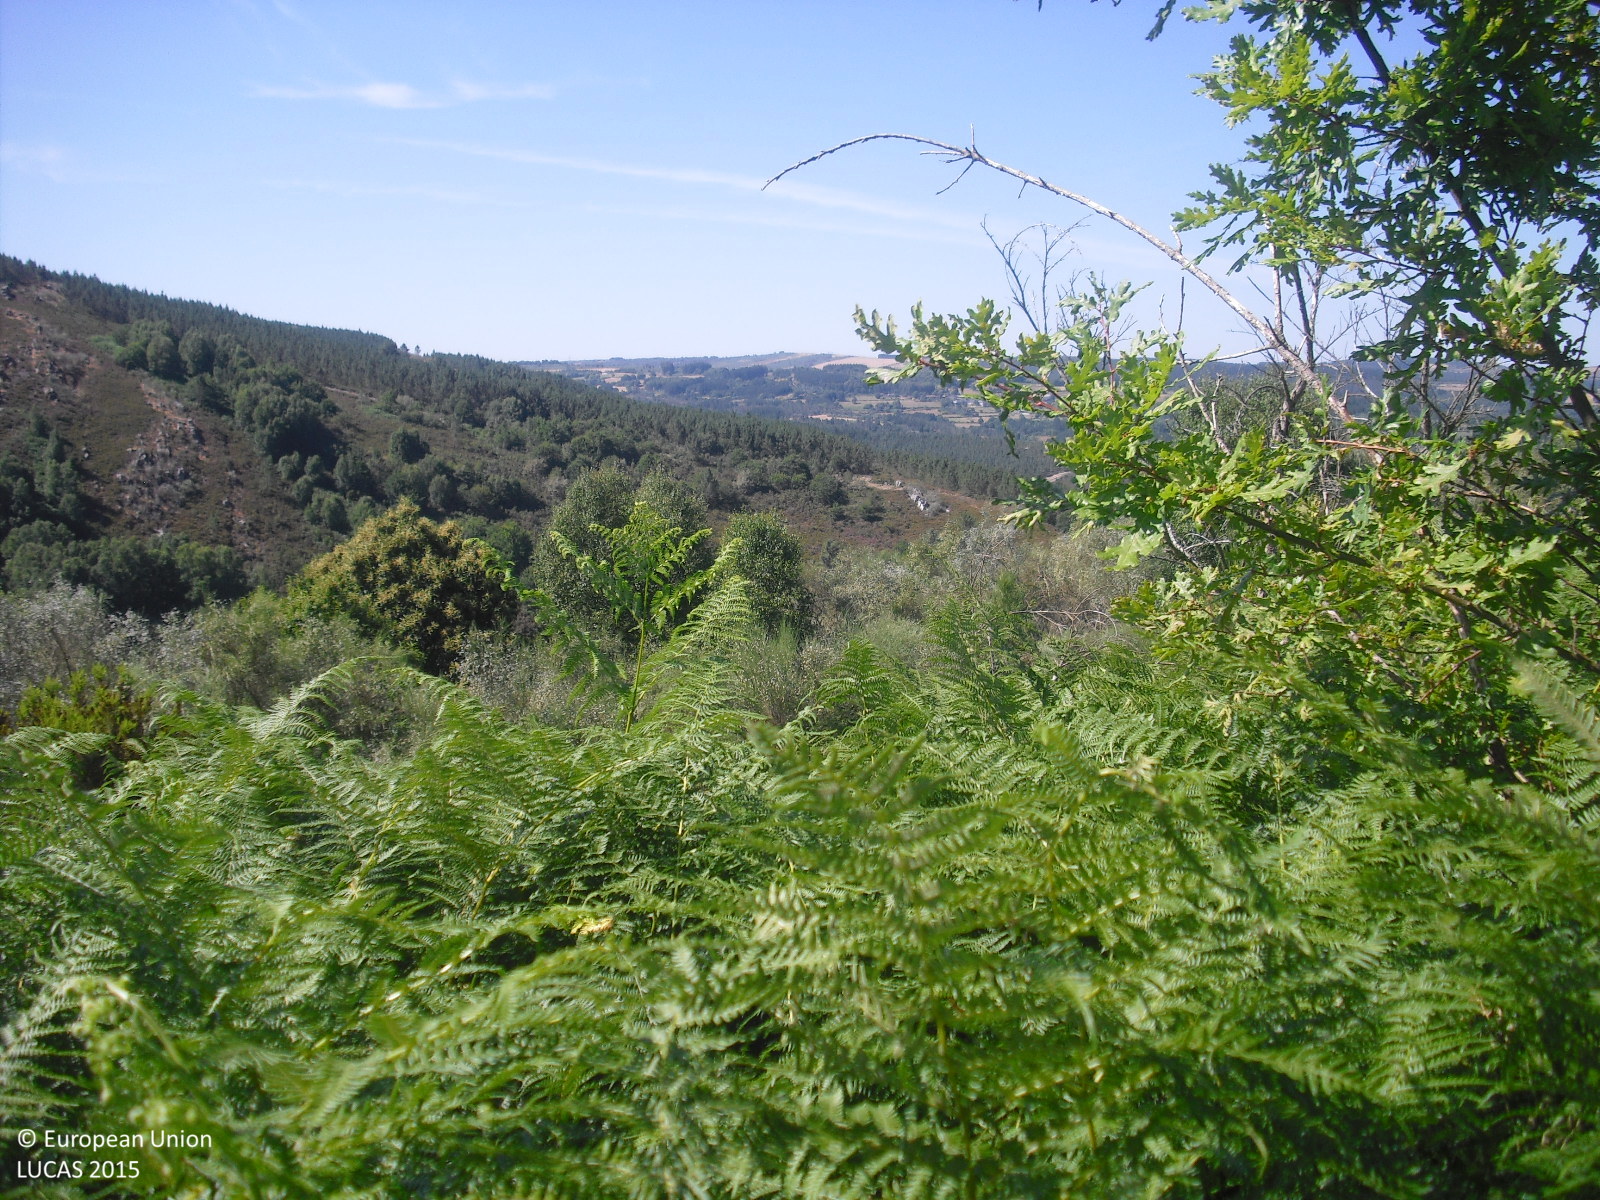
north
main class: Shrubland
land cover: Shrubland with sparse tree cover
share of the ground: > 75 %
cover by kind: shrubs 95 %, broadleaved forest trees 5 %
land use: Forestry
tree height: < 5 m
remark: Burnt area
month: July
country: ES
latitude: 42.6422
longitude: -7.5244
